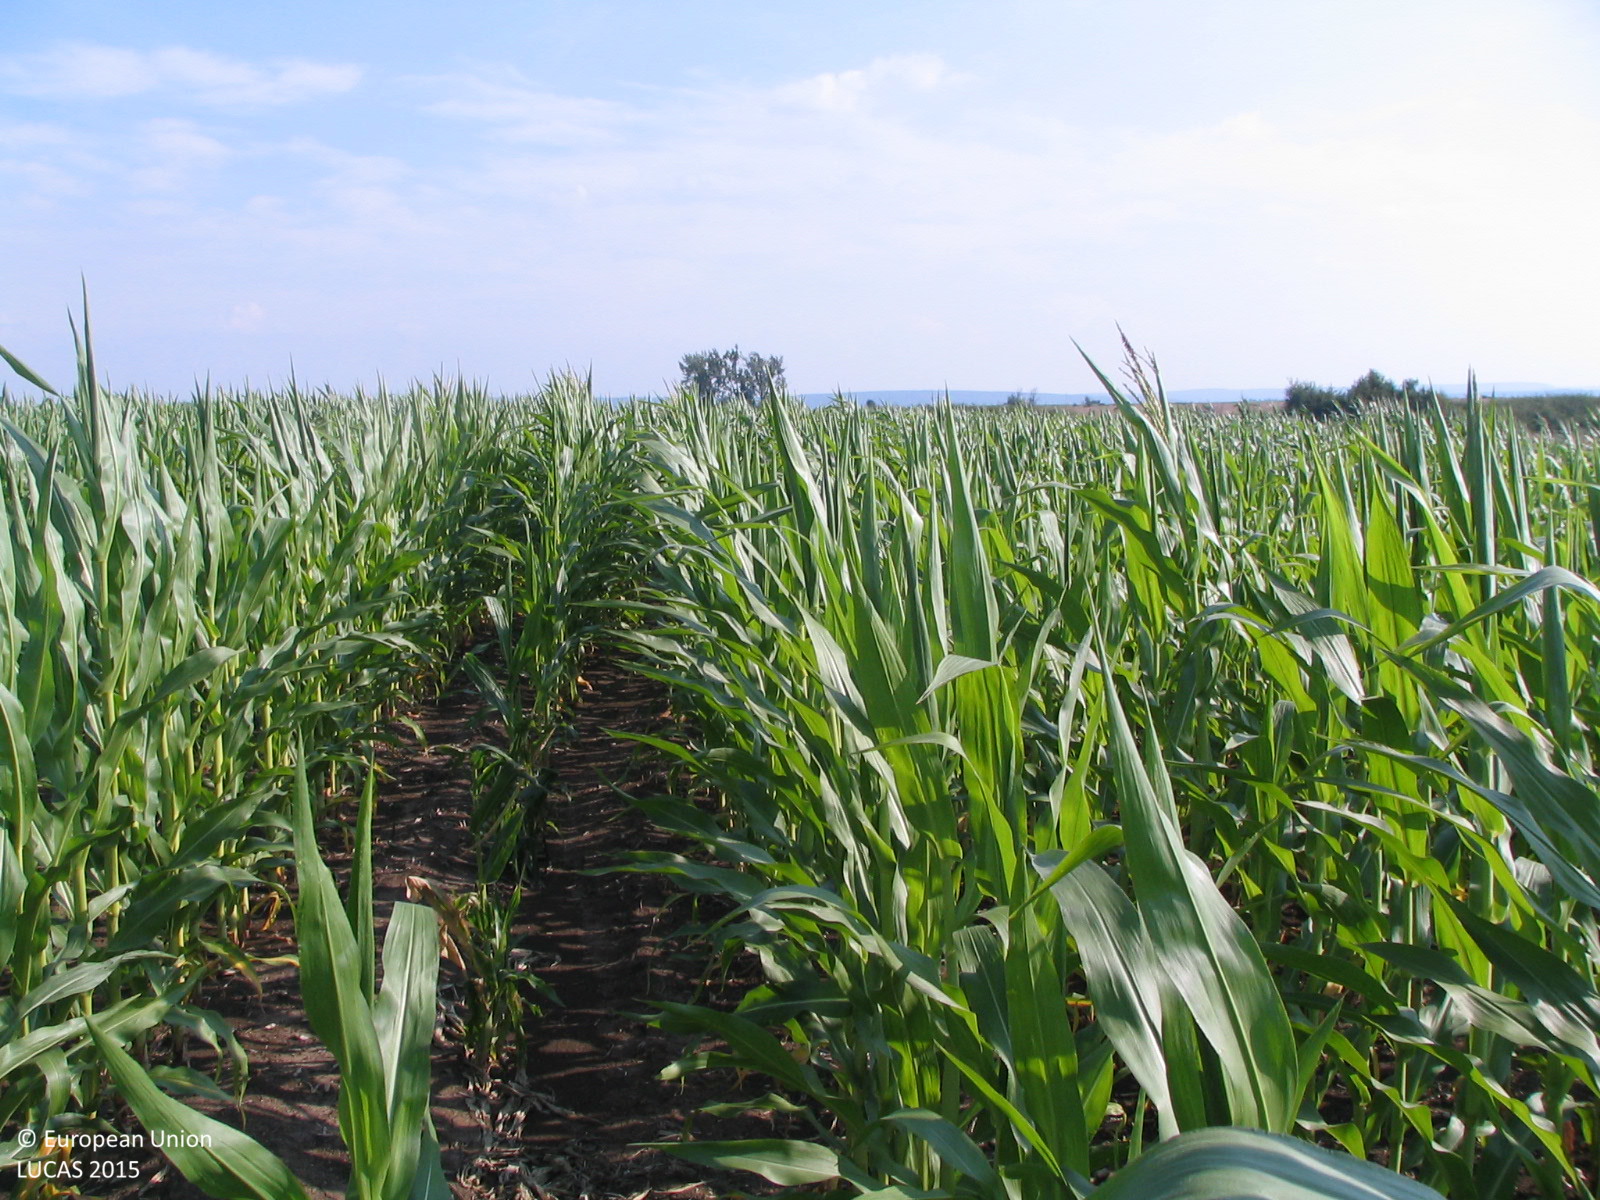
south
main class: Cropland
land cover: Maize
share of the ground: > 75 %
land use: Agriculture (excluding fallow land and kitchen gardens)
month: June
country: BG
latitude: 43.3829
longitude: 23.9623
